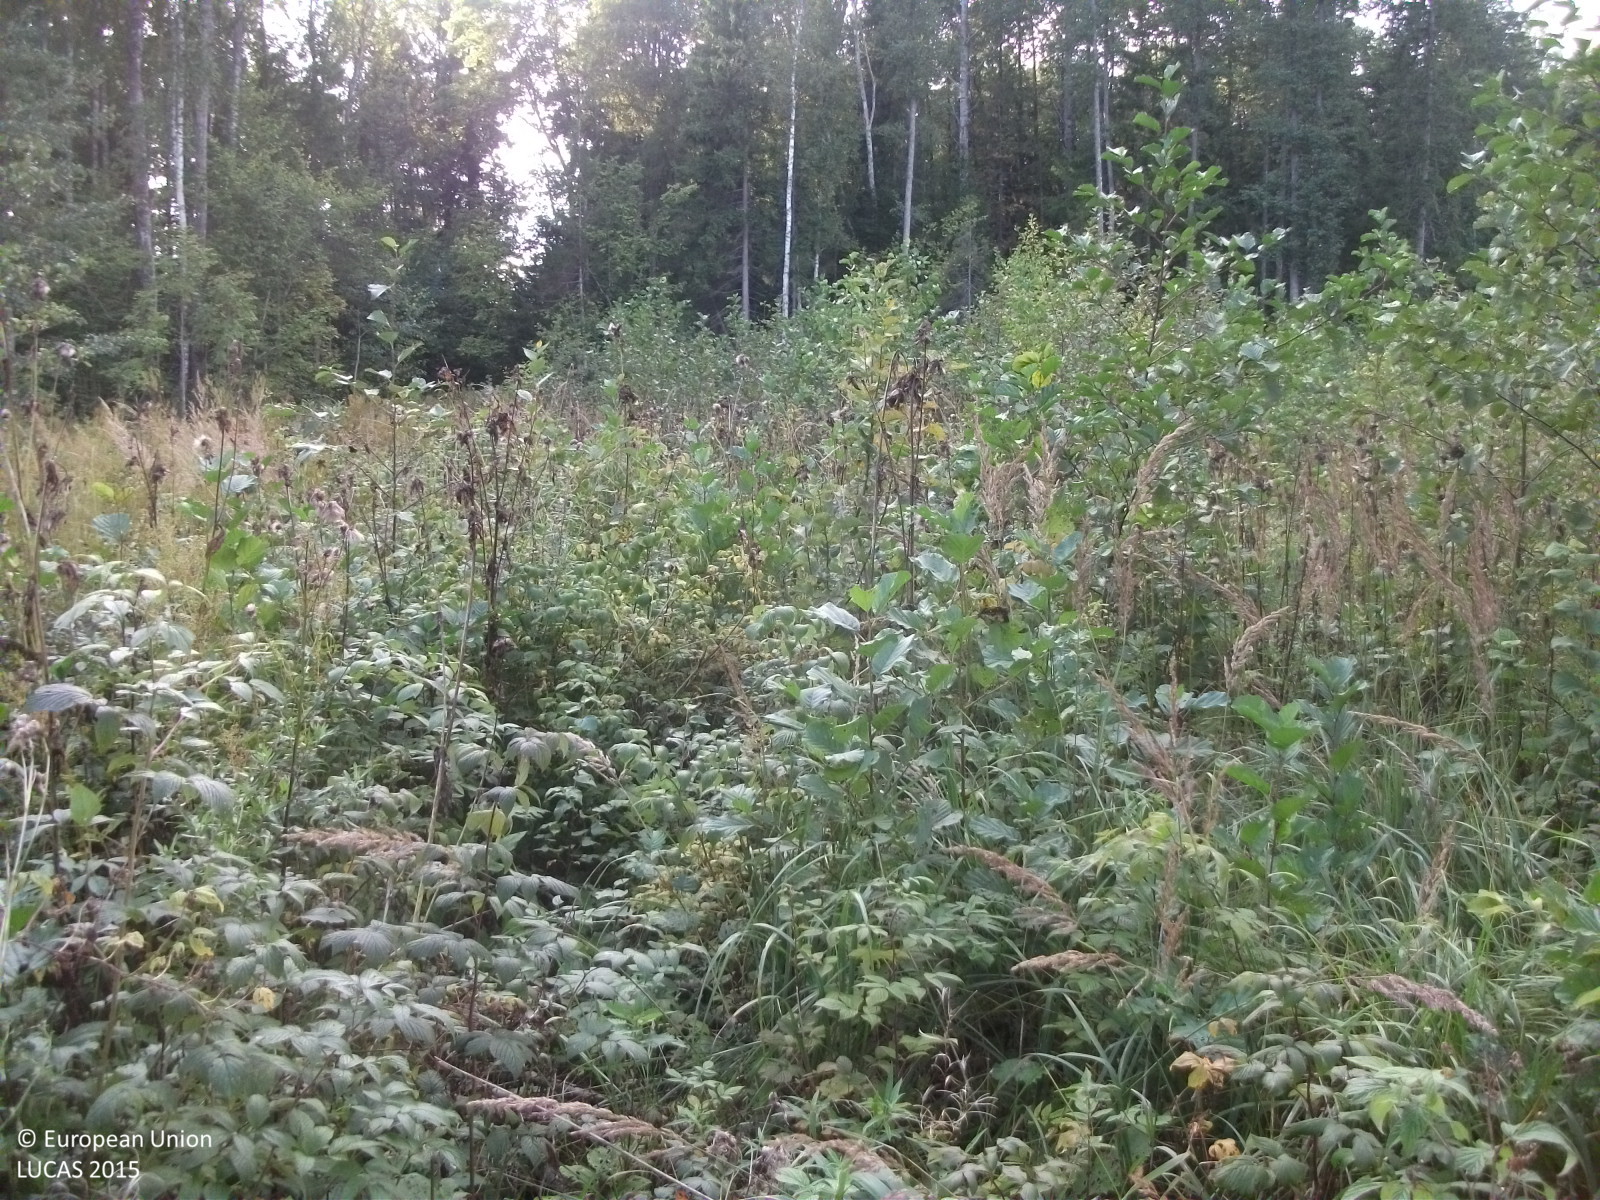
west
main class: Woodland
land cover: Broadleaved woodland
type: non-riverine alder, birch or aspen forest
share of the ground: 50 - 75 %
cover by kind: broadleaved forest trees 50 %, shrubs 35 %, herbaceous plants 10 %, coniferous forest trees 5 %
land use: Forestry
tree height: < 5 m
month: September
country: LV
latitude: 57.6065
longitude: 24.5344
